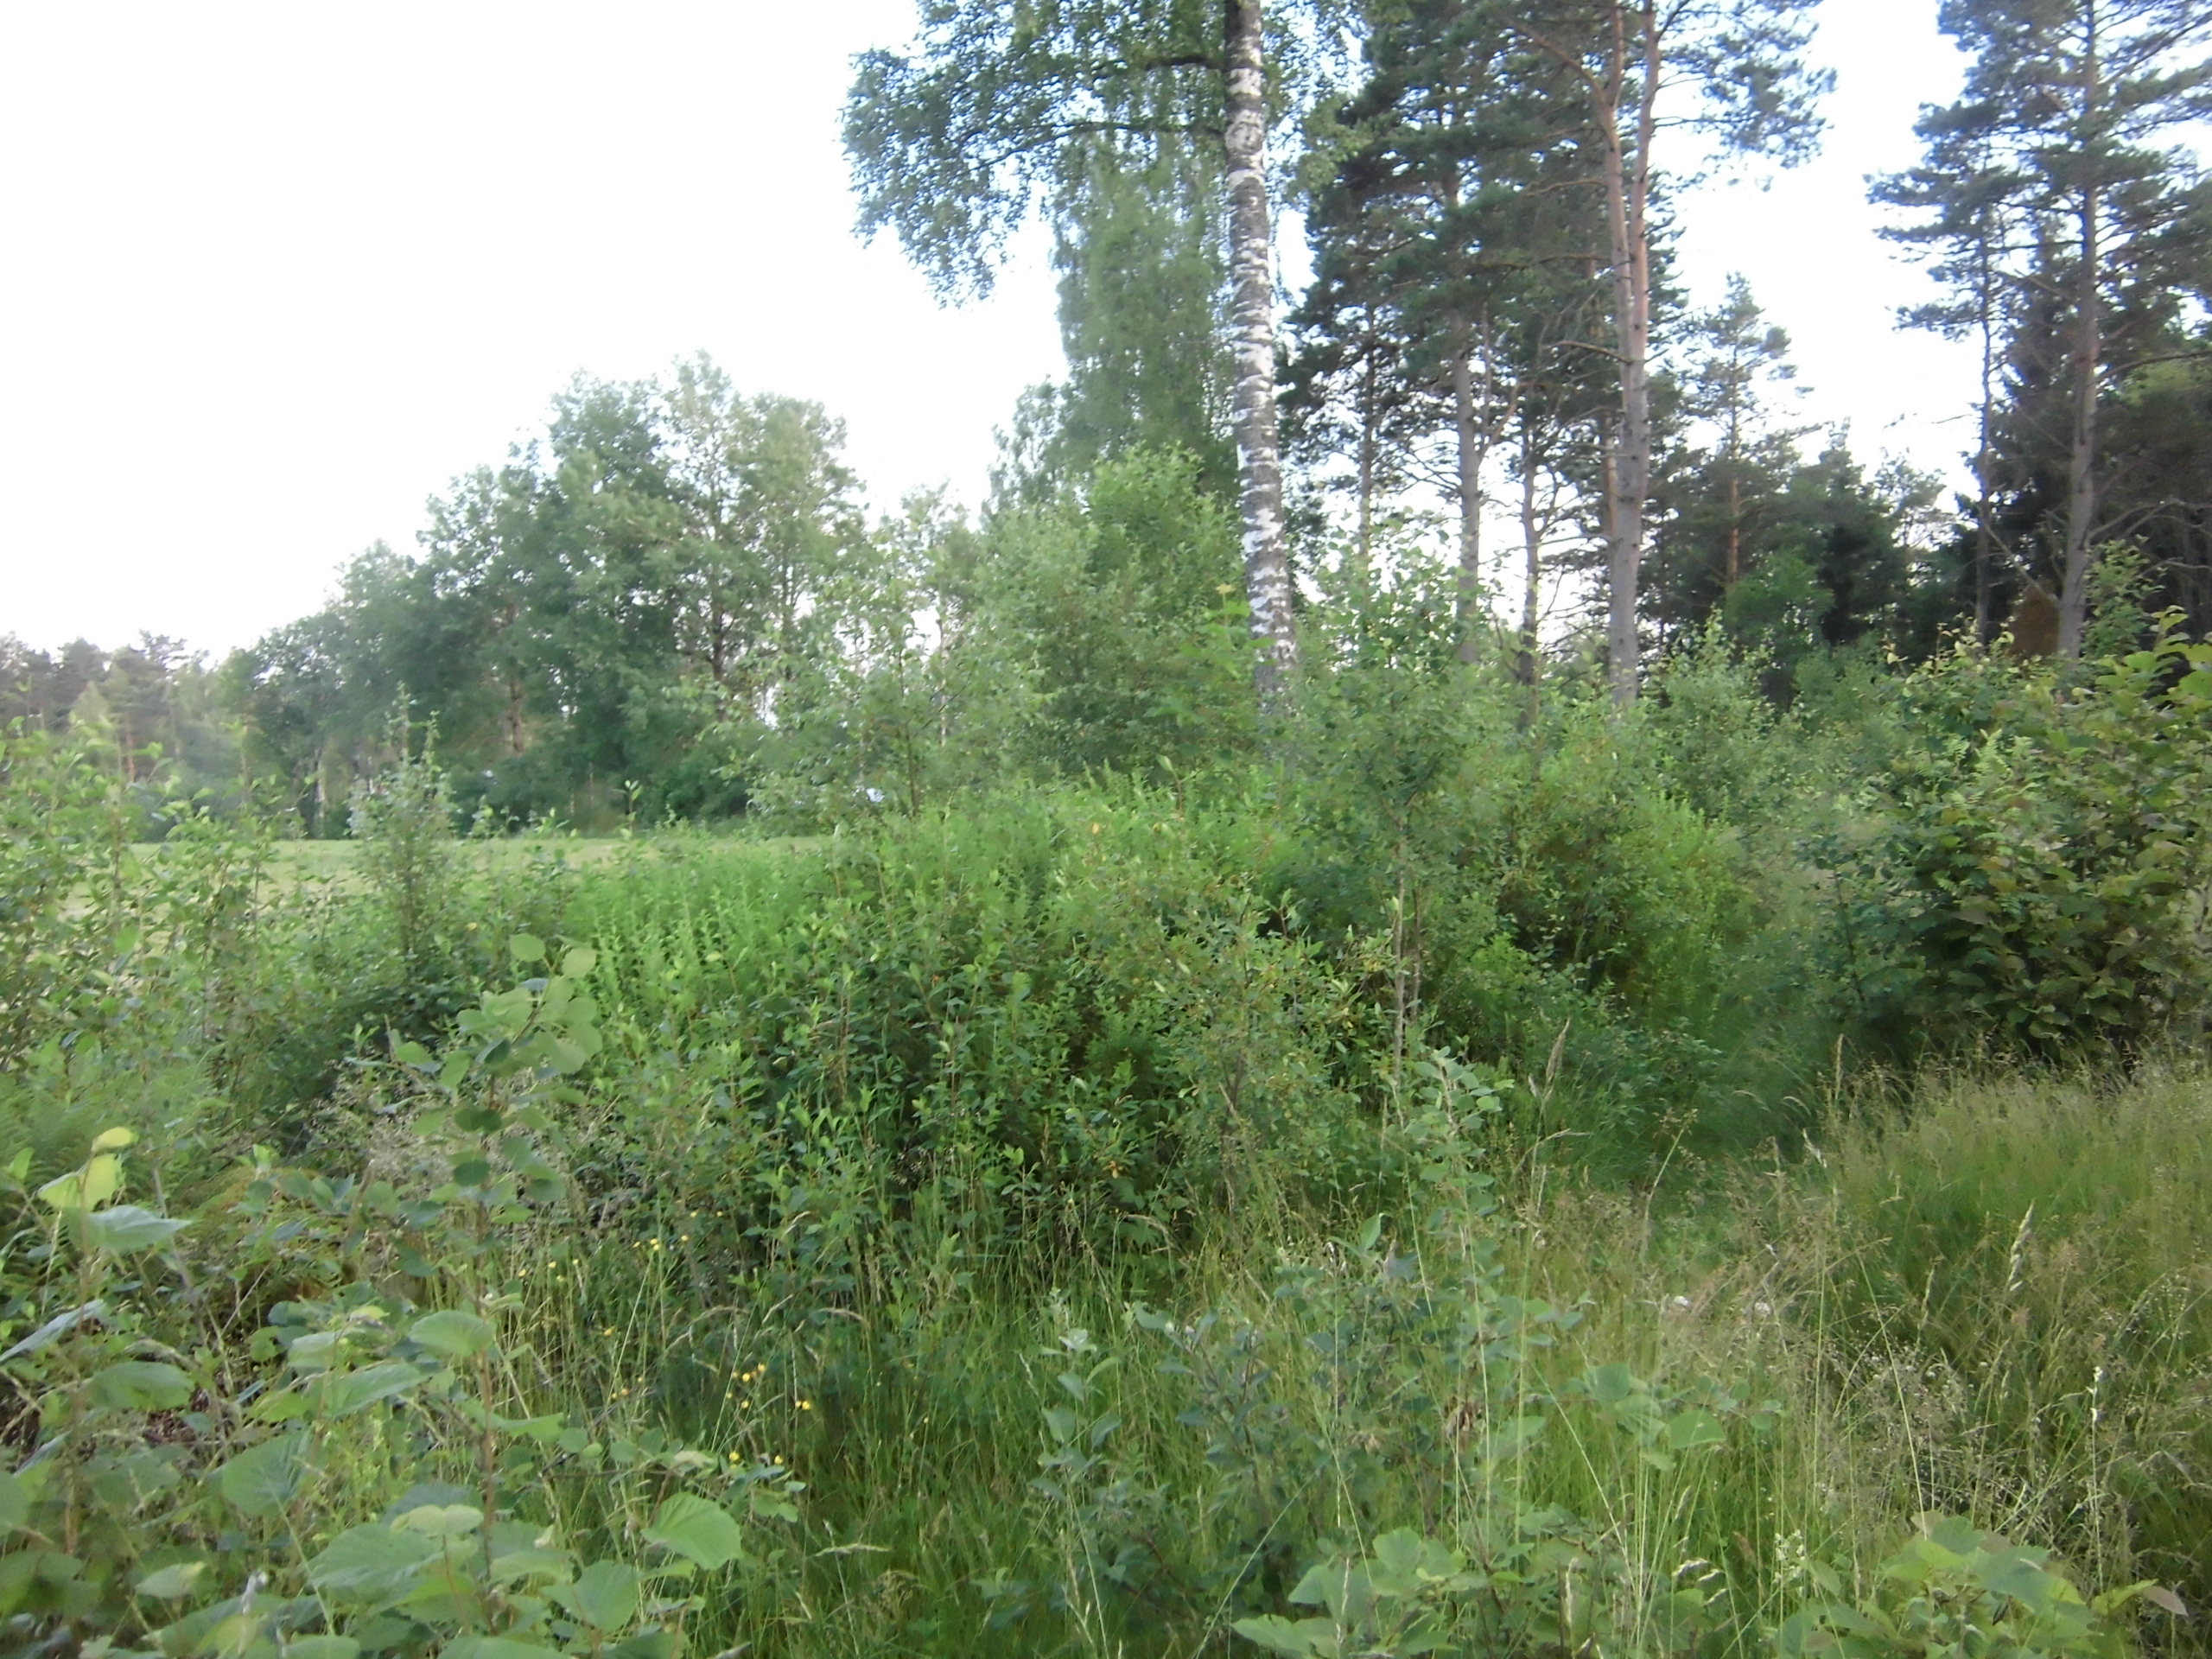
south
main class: Woodland
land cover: Broadleaved woodland
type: hemiboreal forest and nemoral coniferous forest and mixed broadleaved-coniferous forest
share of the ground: 50 - 75 %
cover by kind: broadleaved forest trees 50 %, herbaceous plants 30 %, shrubs 10 %, coniferous forest trees 5 %, lichens and mosses 5 %
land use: Forestry
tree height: > 5 m
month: July
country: SE
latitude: 57.2861
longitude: 14.8241
